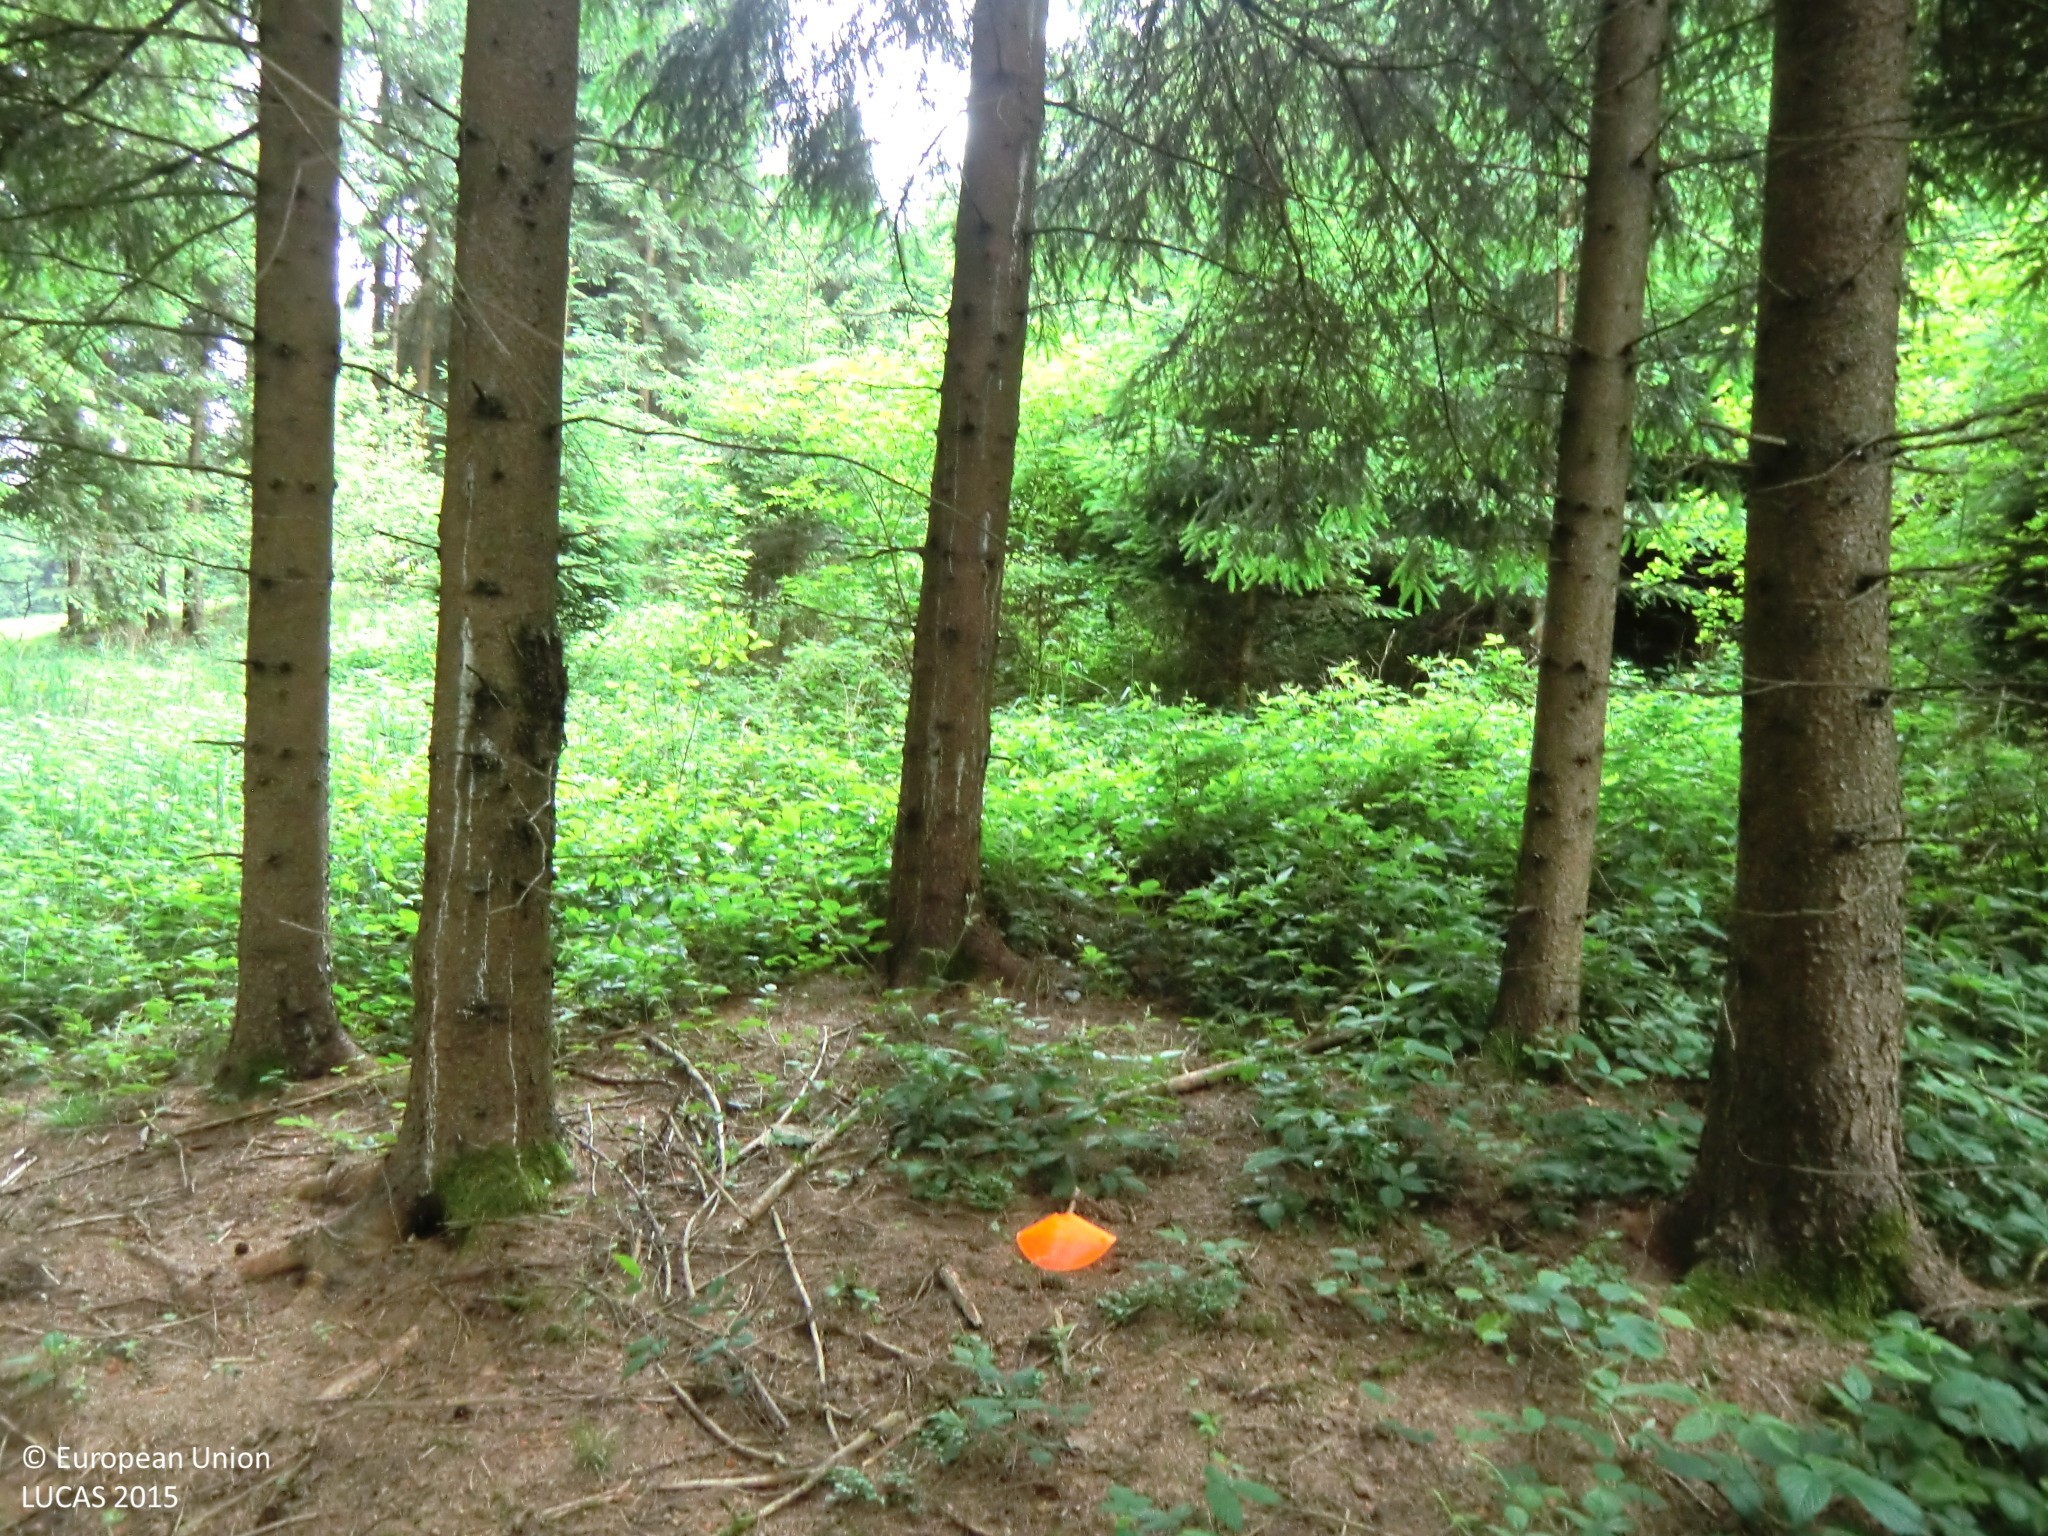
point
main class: Woodland
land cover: Spruce dominated coniferous woodland
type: hemiboreal forest and nemoral coniferous forest and mixed broadleaved-coniferous forest
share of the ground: > 75 %
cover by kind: coniferous forest trees 90 %, unconsolidated bare surface 10 %
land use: Forestry
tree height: > 5 m
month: June
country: AT
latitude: 48.2700
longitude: 15.0537
